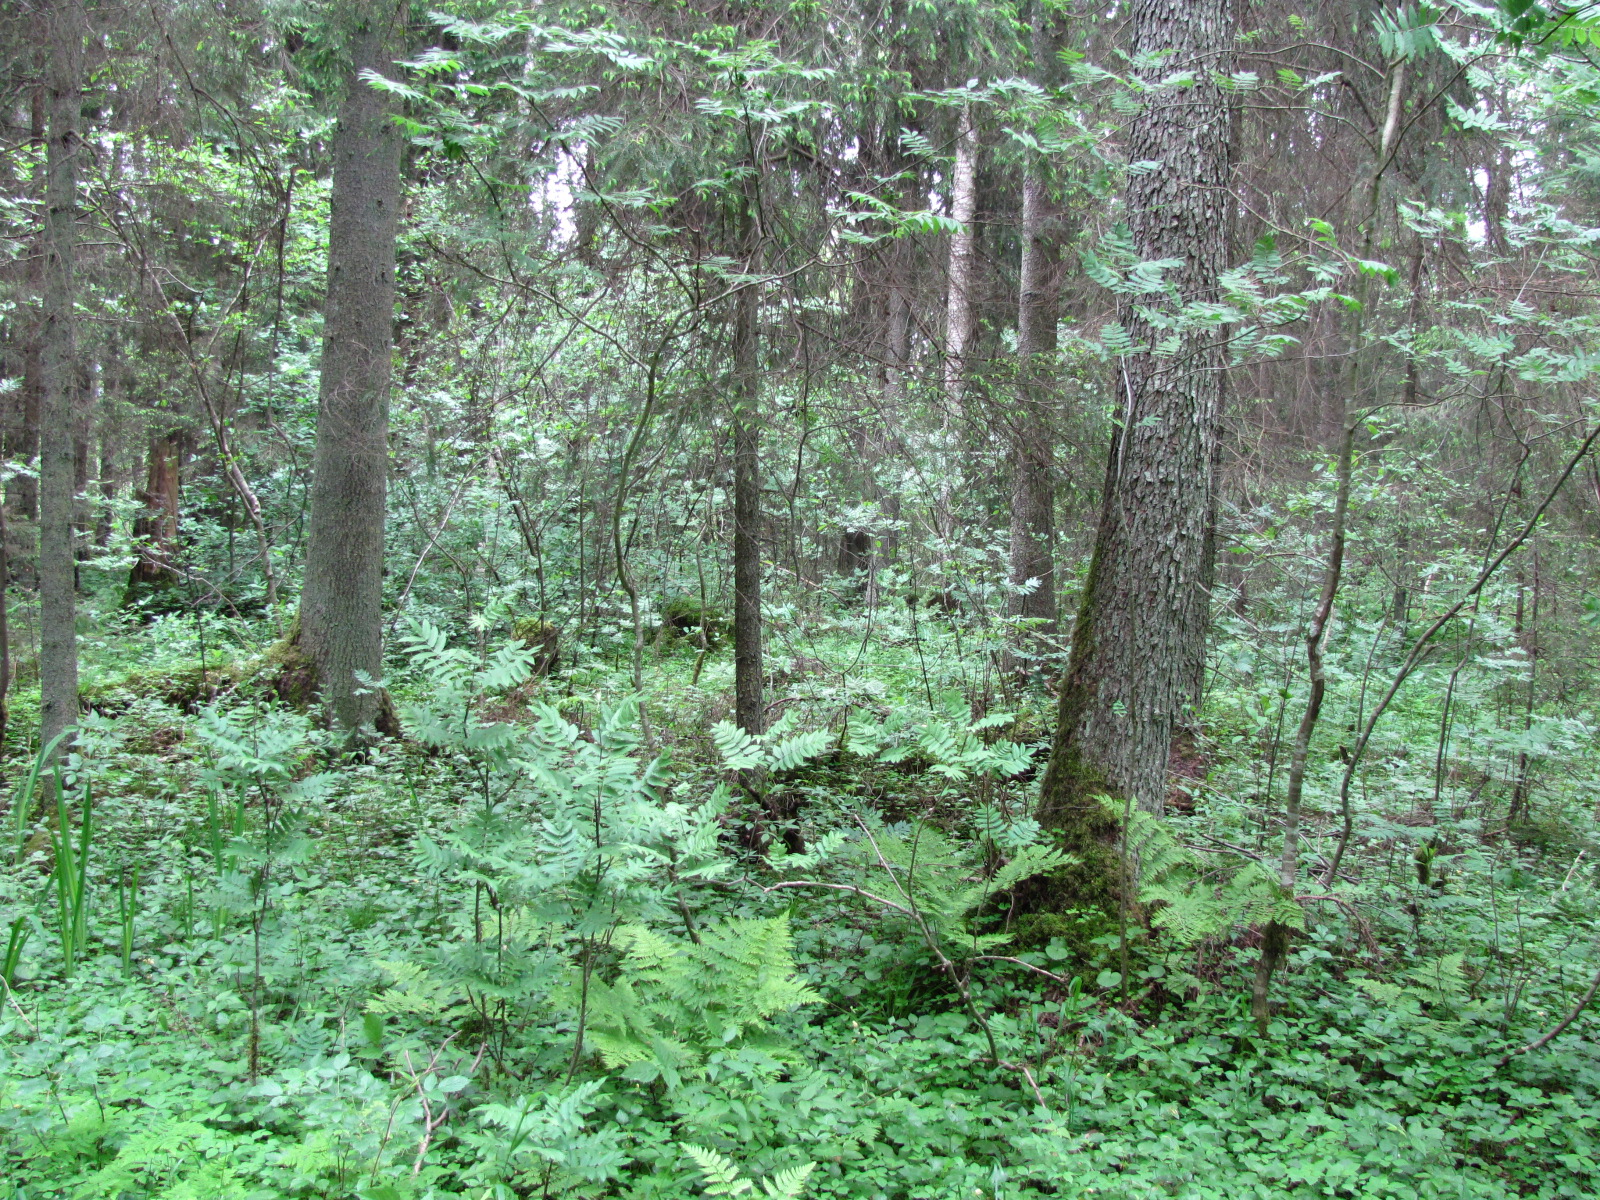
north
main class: Woodland
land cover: Spruce dominated mixed woodland
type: hemiboreal forest and nemoral coniferous forest and mixed broadleaved-coniferous forest
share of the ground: > 75 %
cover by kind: coniferous forest trees 50 %, broadleaved forest trees 50 %
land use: Forestry
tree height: > 5 m
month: June
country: LV
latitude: 56.8341
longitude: 24.0655
